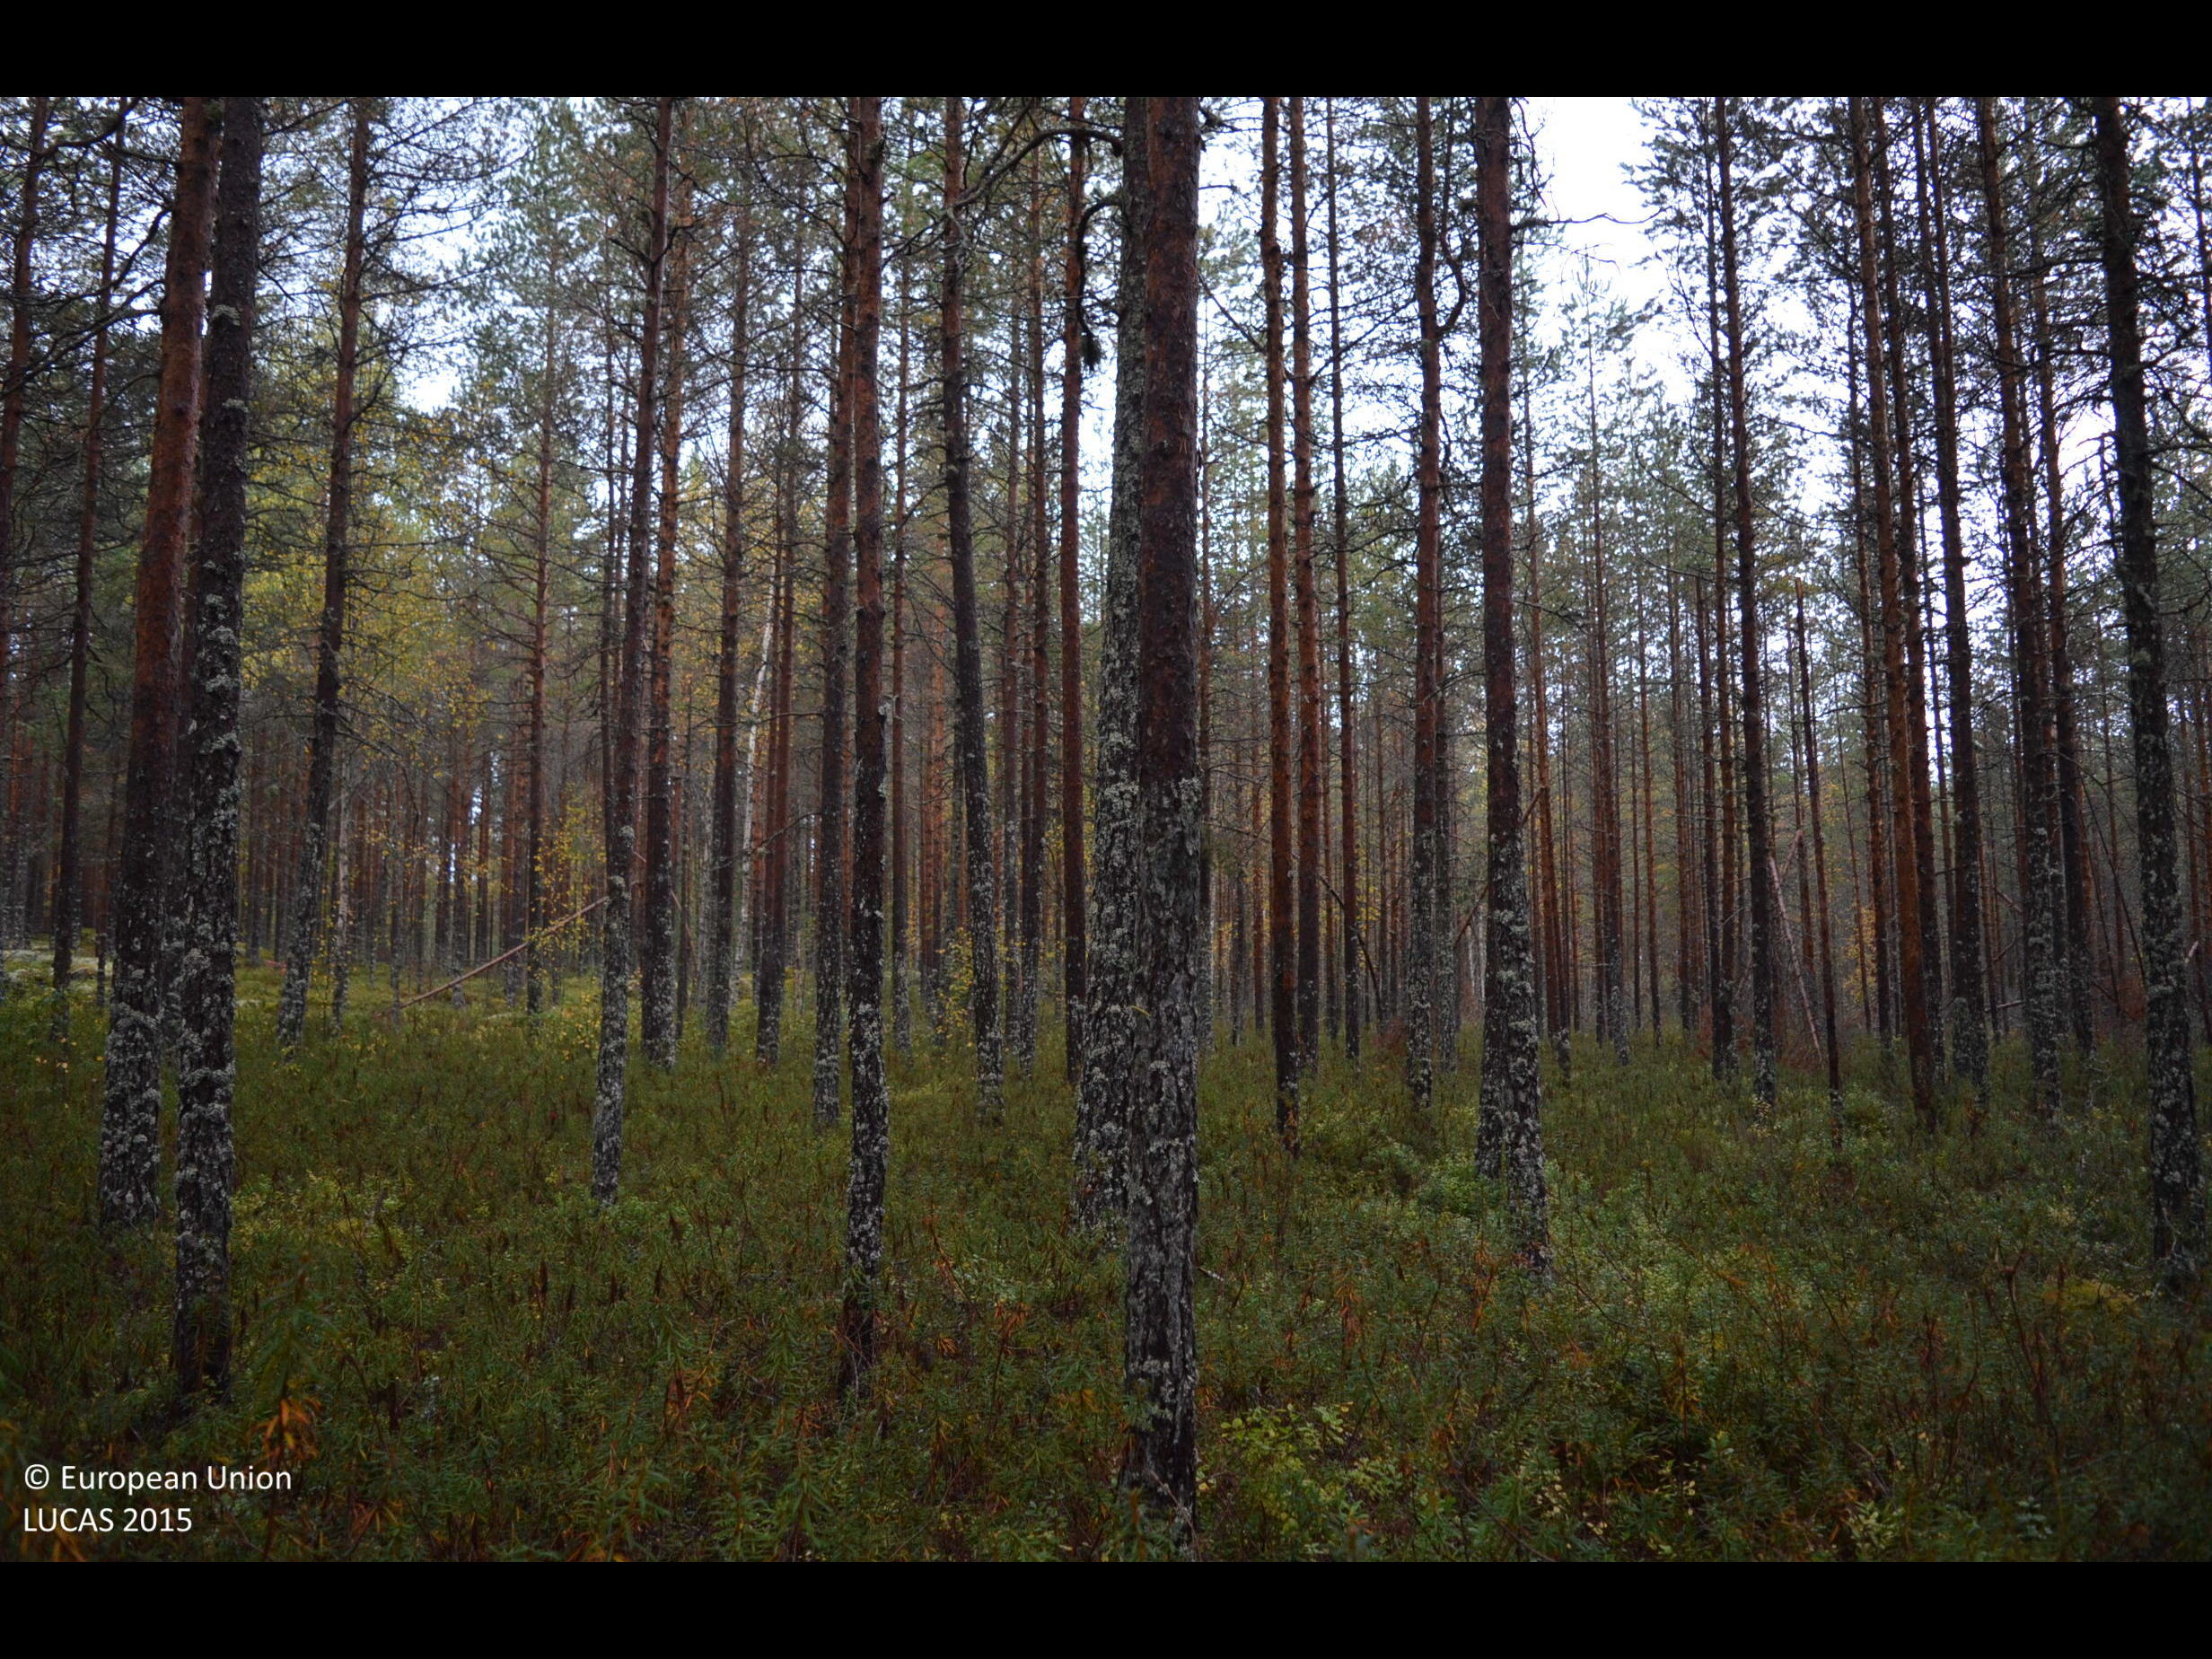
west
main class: Woodland
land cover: Pine dominated coniferous woodland
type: boreal forest
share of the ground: > 75 %
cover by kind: coniferous forest trees 65 %, shrubs 25 %, broadleaved forest trees 10 %
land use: Forestry
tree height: > 5 m
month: September
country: FI
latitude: 62.8854
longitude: 23.8602
